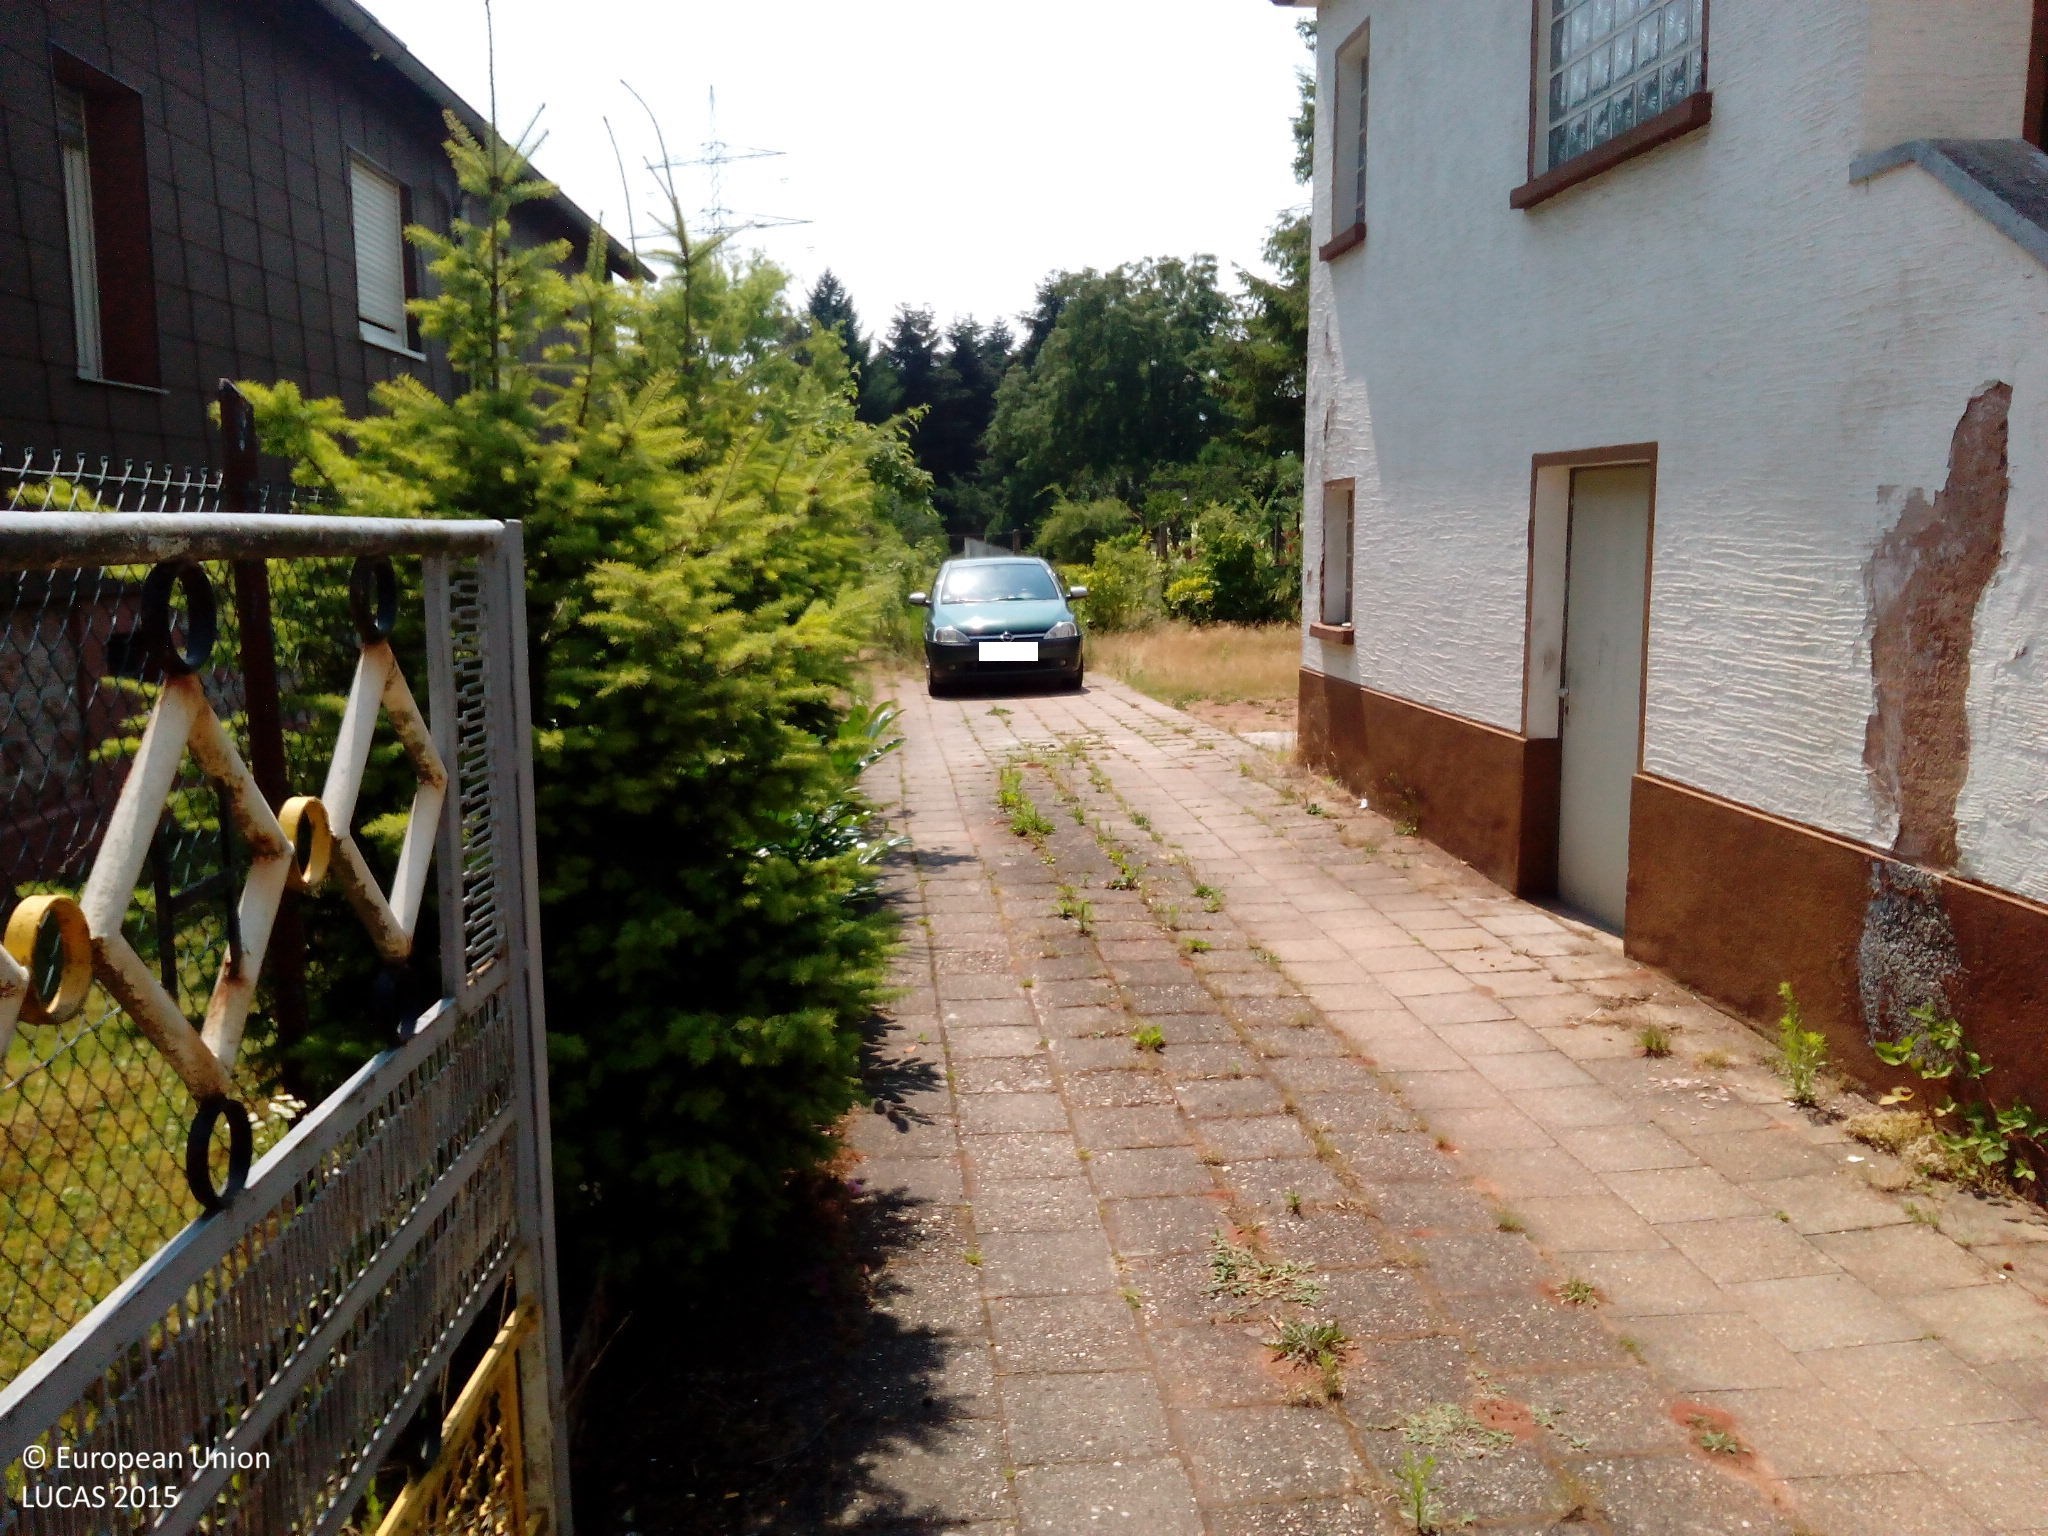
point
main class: Shrubland
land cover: Shrubland without tree cover
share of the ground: > 75 %
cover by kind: herbaceous plants 70 %, shrubs 20 %, unconsolidated bare surface 10 %
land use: Residential
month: July
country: DE
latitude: 49.4564
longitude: 7.5586
